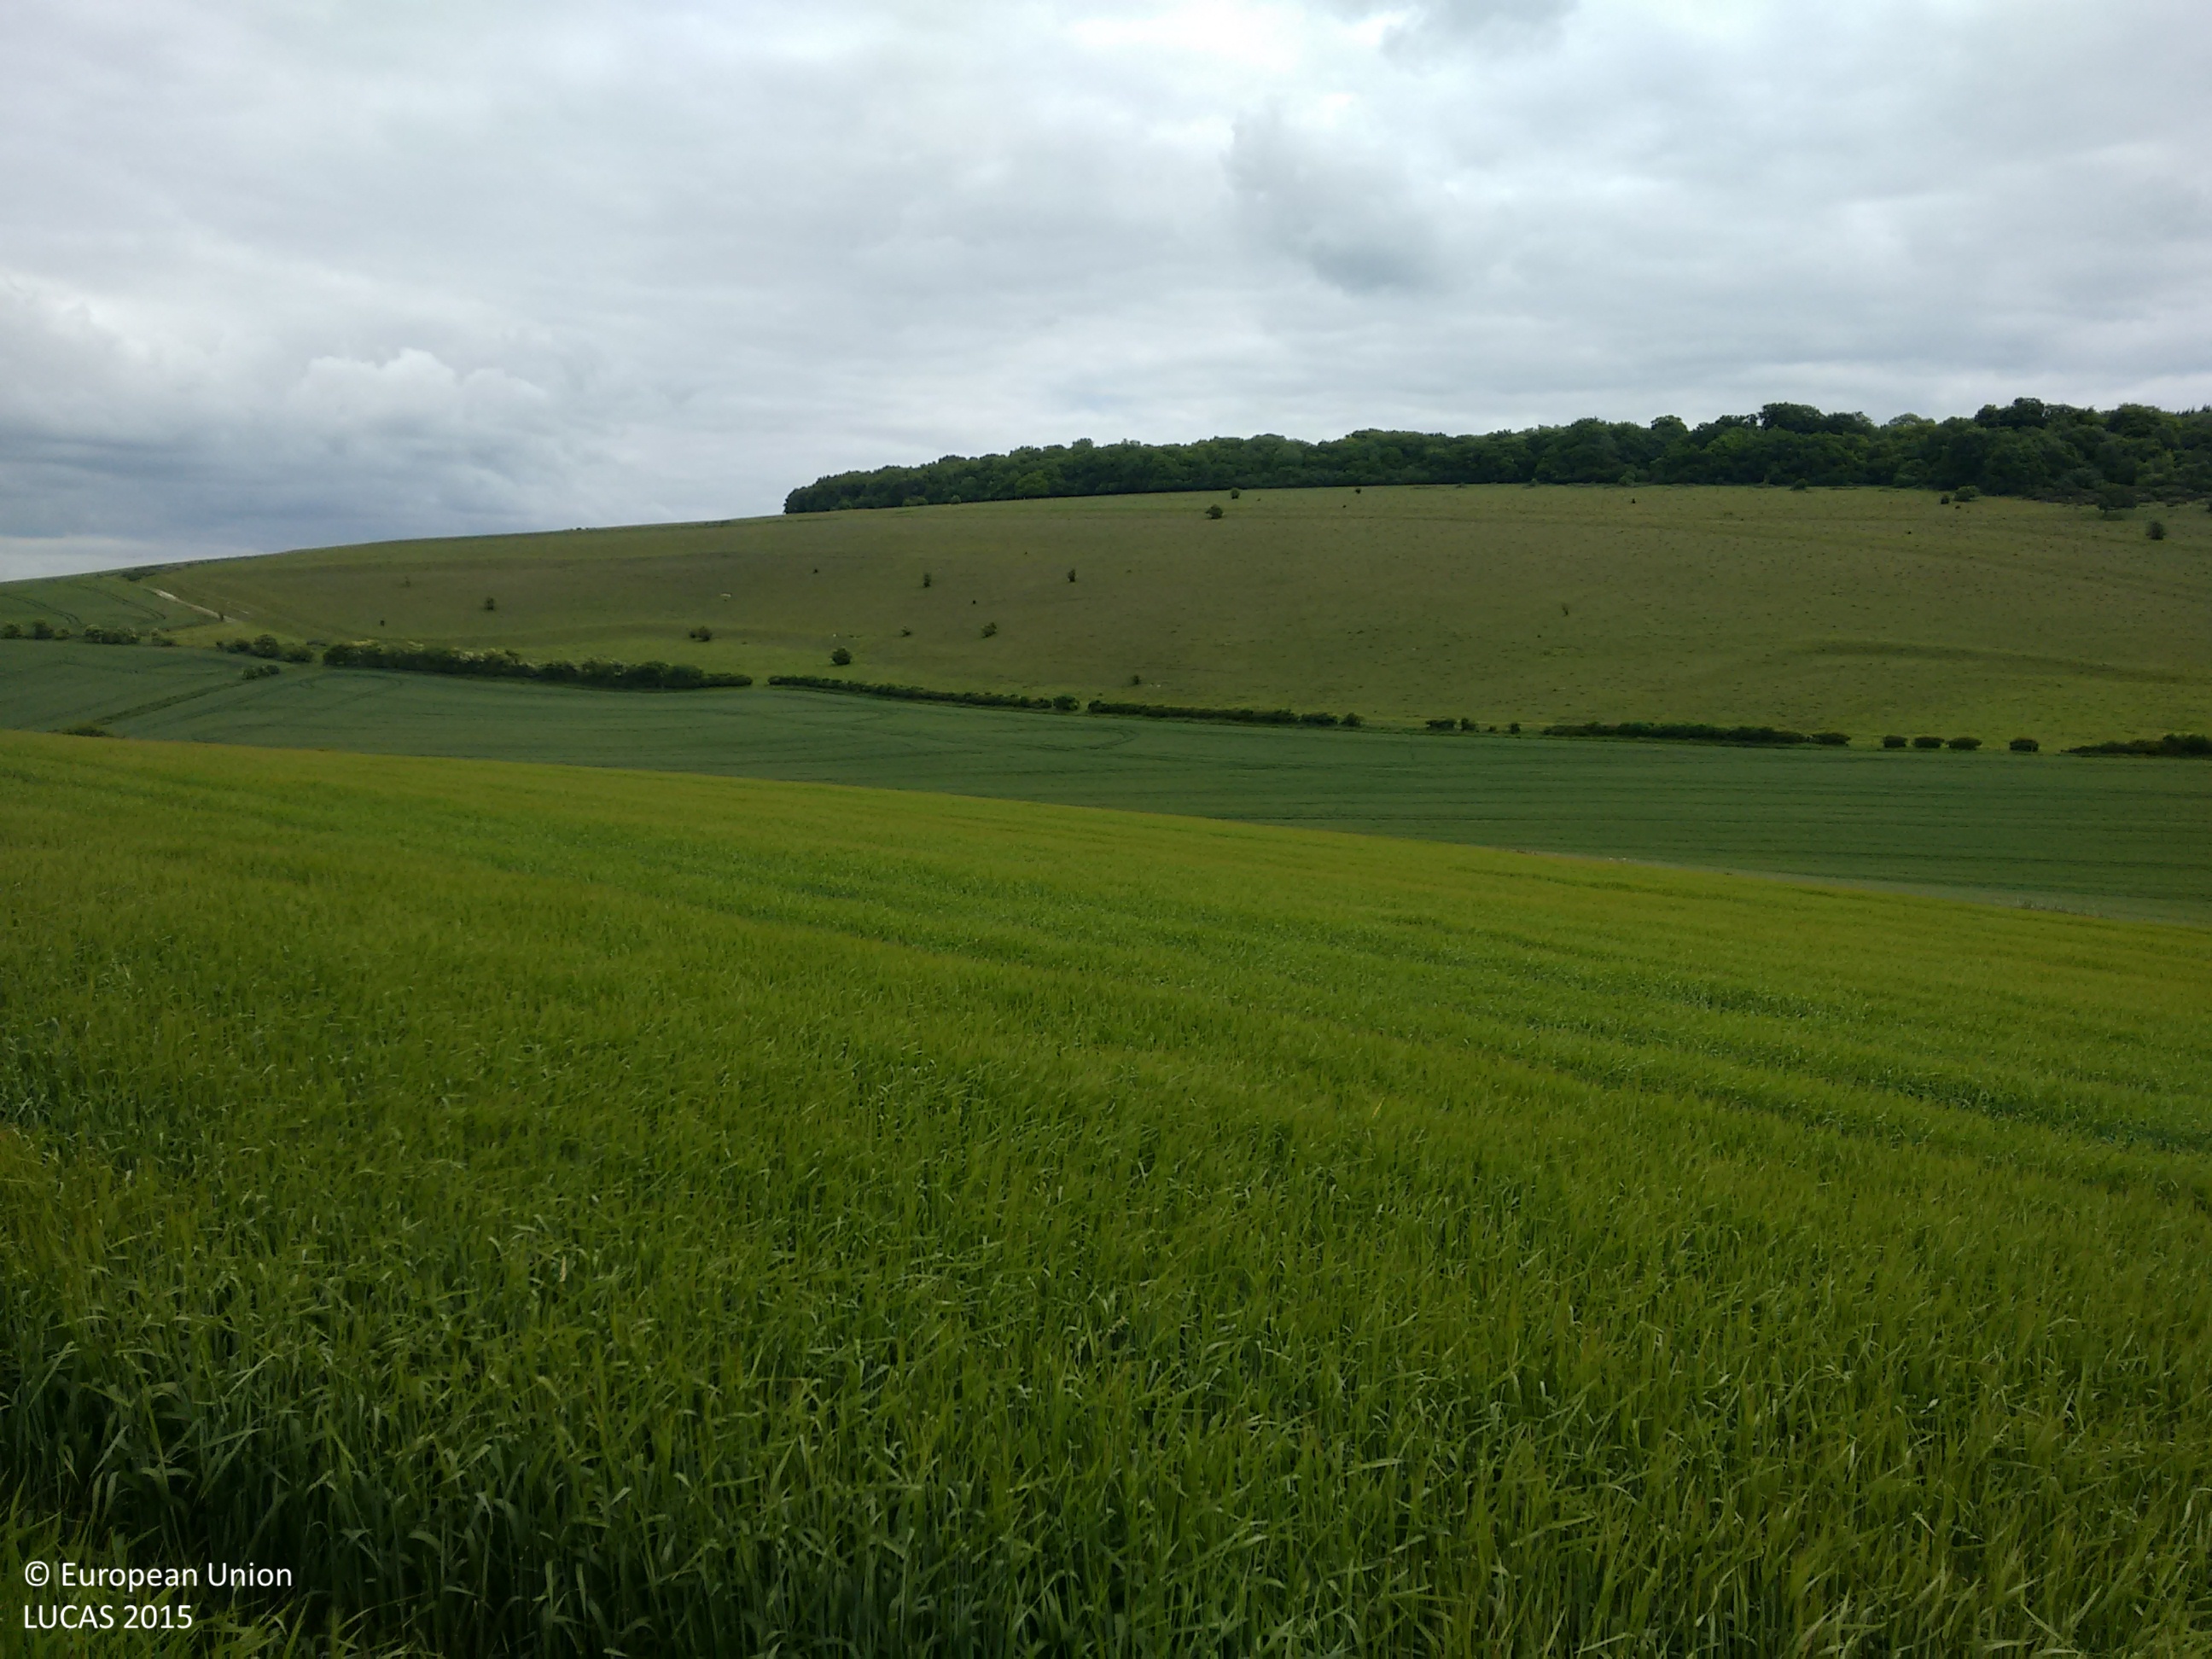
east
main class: Cropland
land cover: Barley
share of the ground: > 75 %
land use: Agriculture (excluding fallow land and kitchen gardens)
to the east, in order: Barley; Shruby margins; Fences; Shruby margins; Tracks; Common wheat
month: June
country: GB
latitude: 51.1188
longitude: -1.9293
